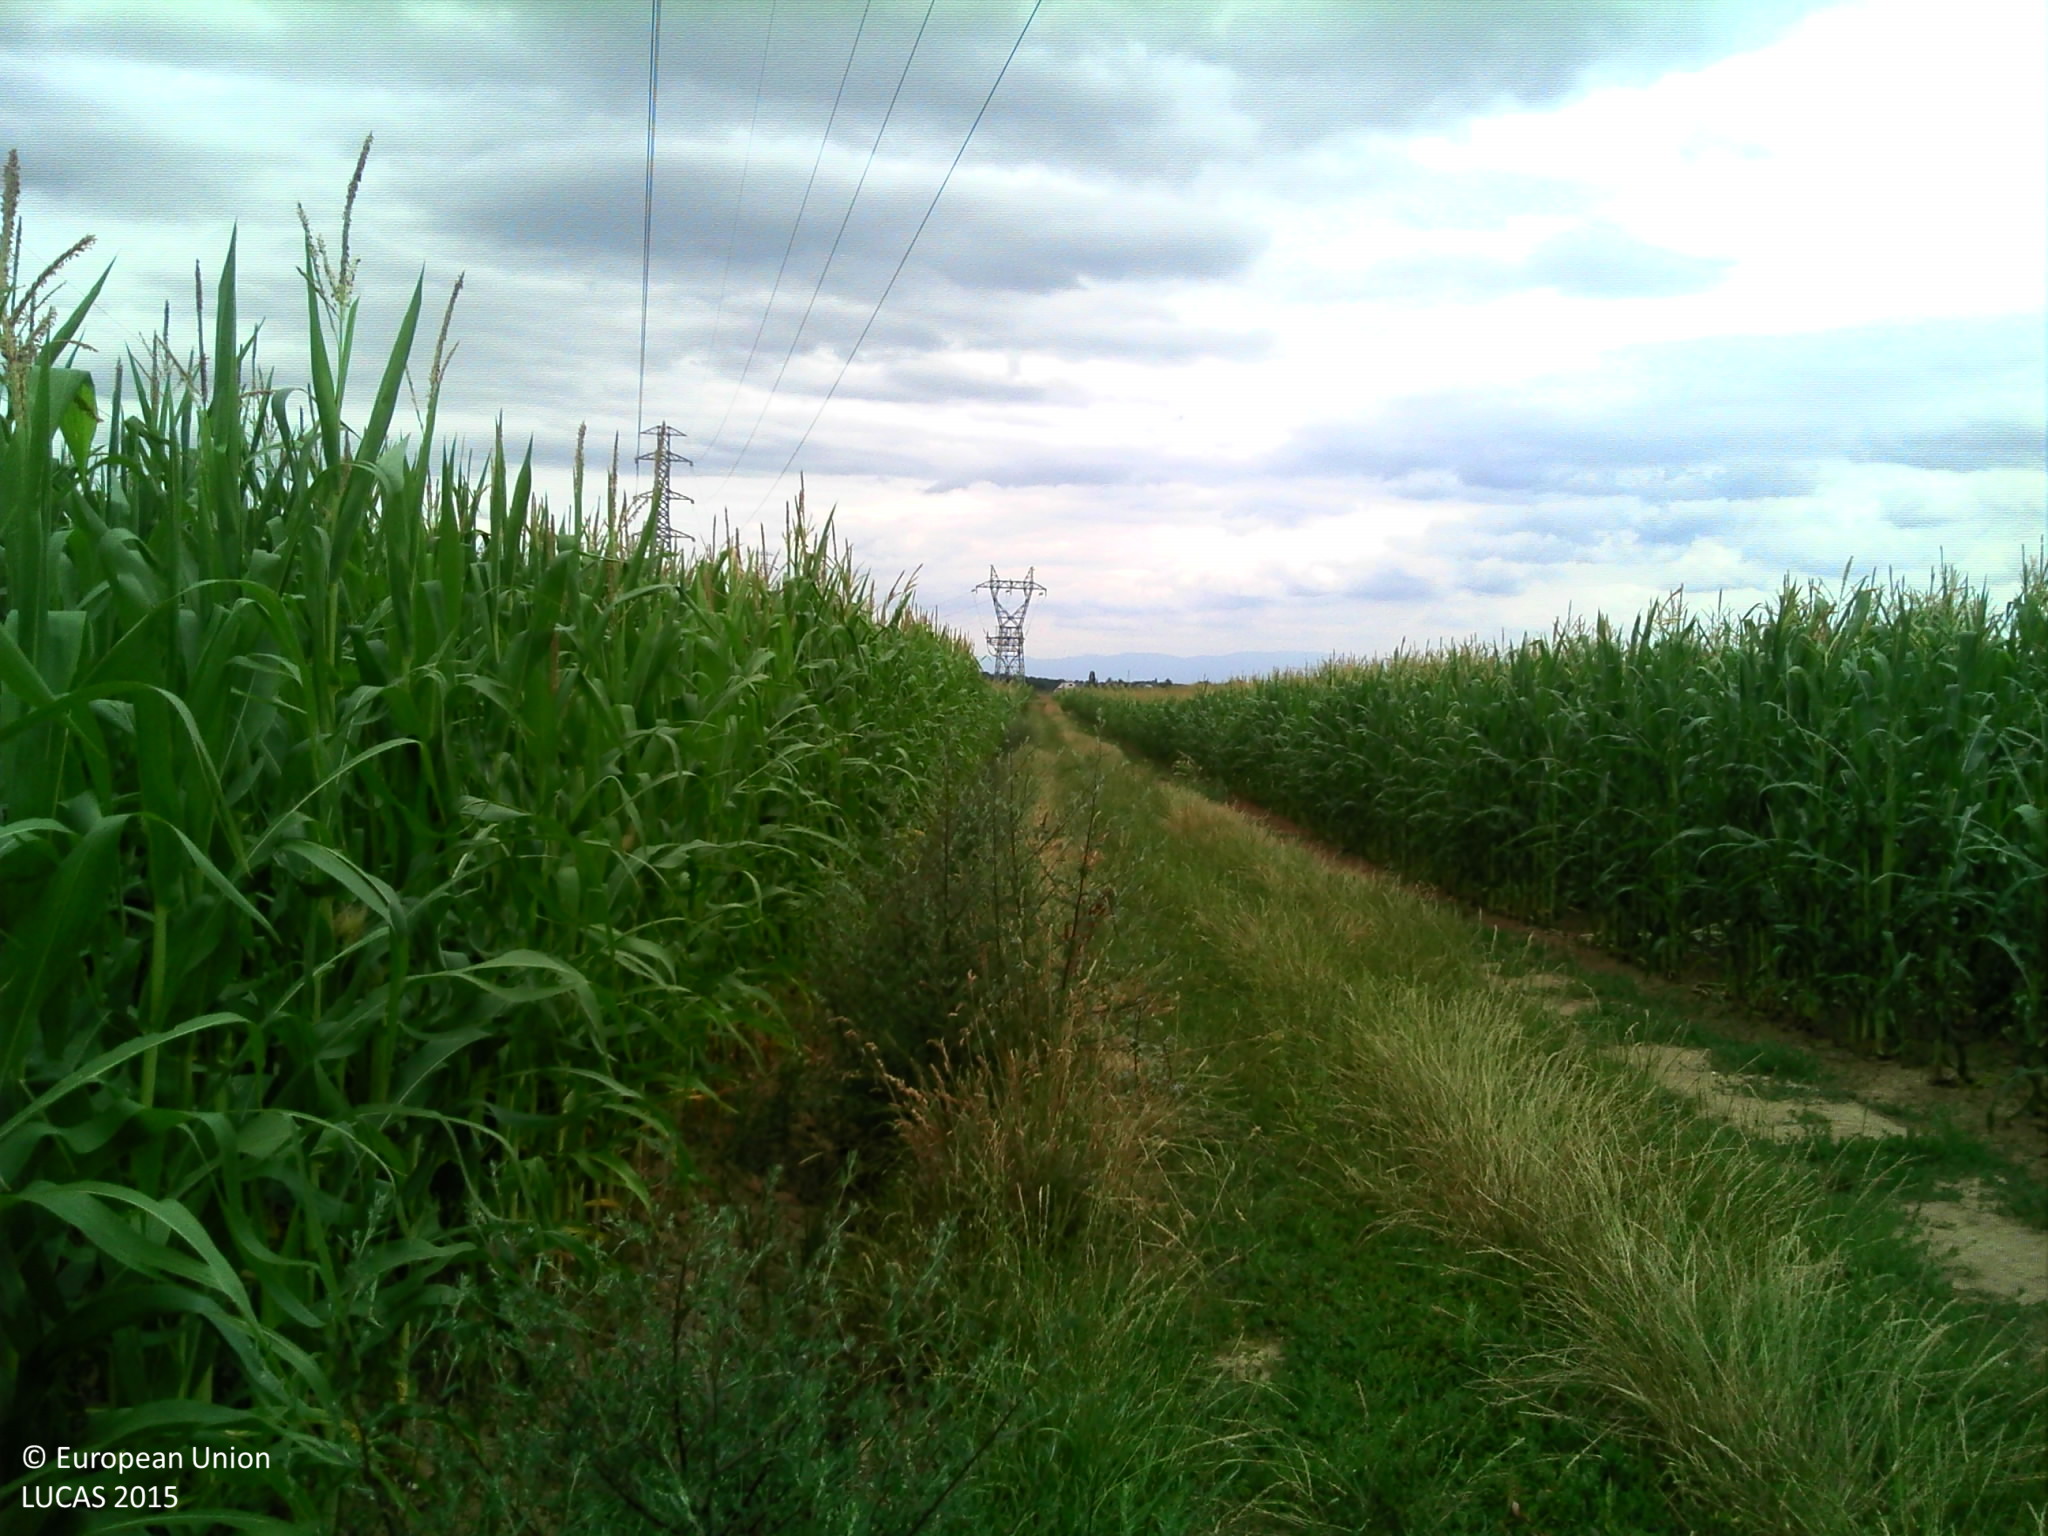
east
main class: Cropland
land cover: Maize
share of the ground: > 75 %
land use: Agriculture (excluding fallow land and kitchen gardens)
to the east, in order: Maize; Electric lines; Maize; Tracks; Maize
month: July
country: FR
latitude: 48.6474
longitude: 7.5983
